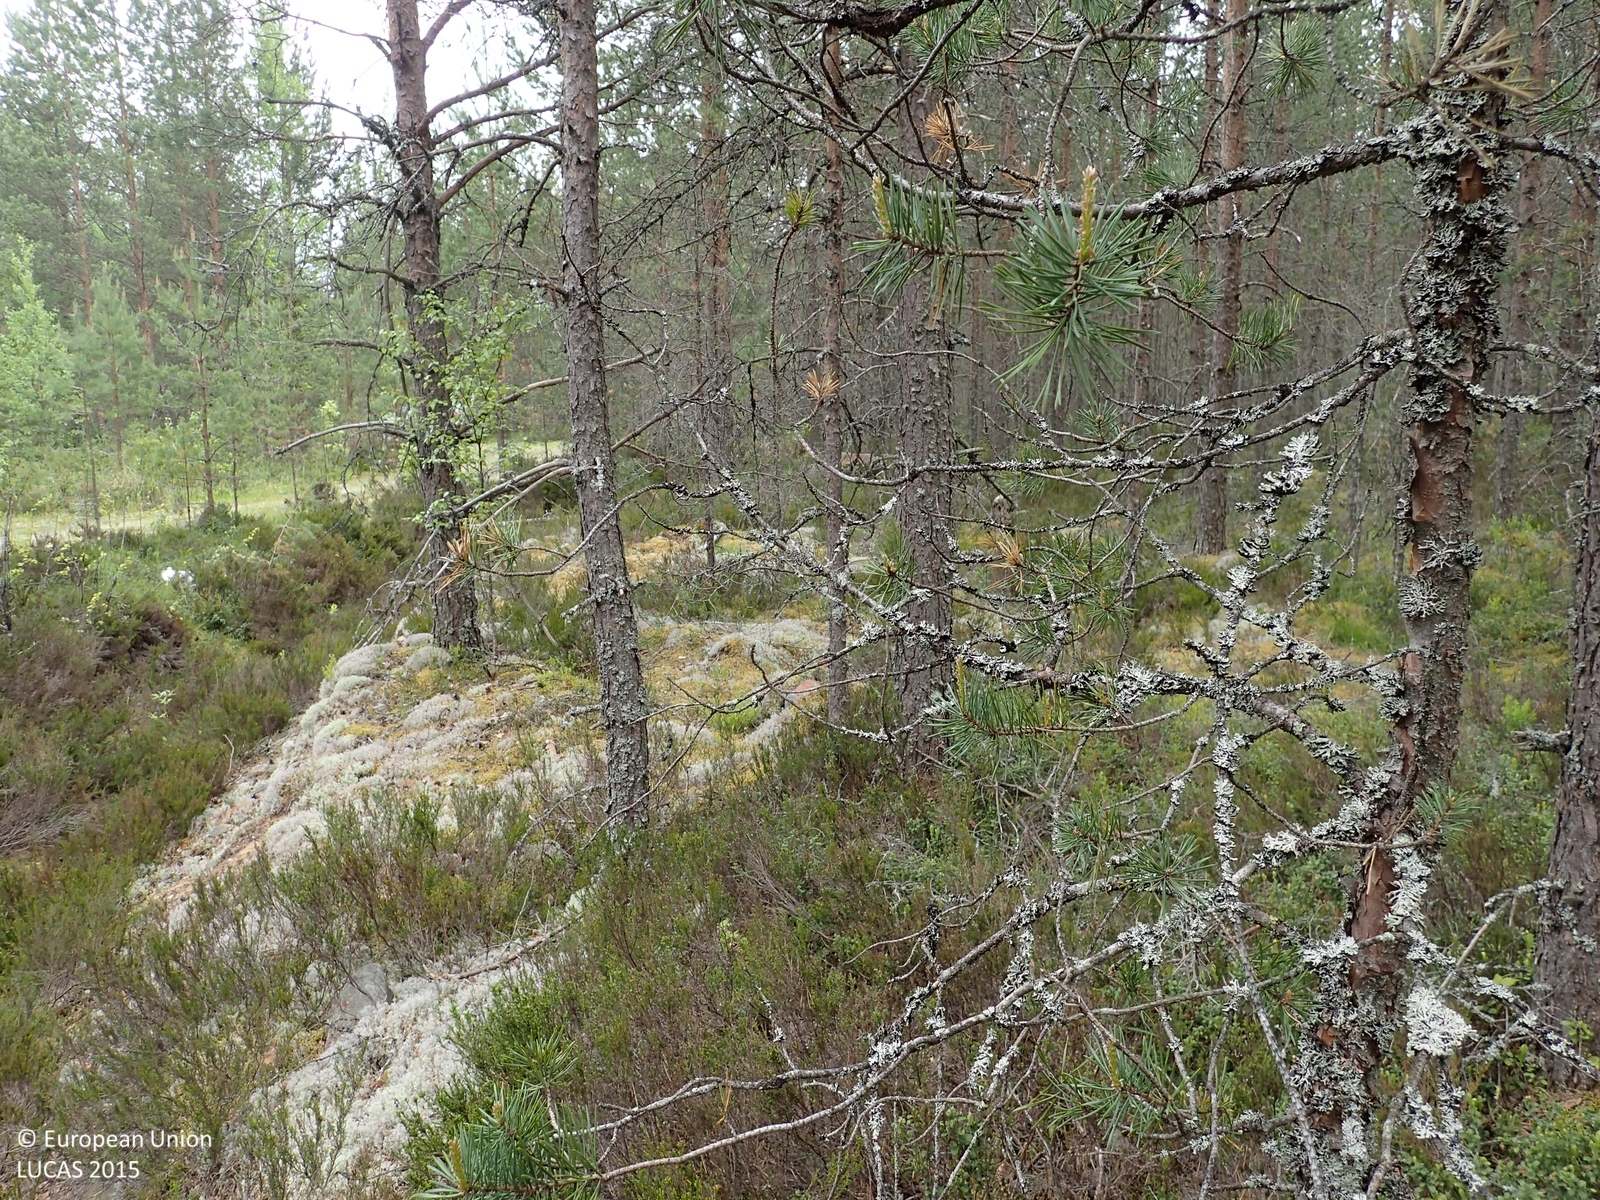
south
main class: Woodland
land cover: Pine dominated coniferous woodland
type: boreal forest
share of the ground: 50 - 75 %
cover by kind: coniferous forest trees 60 %, shrubs 35 %, broadleaved forest trees 5 %
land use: Forestry
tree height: > 5 m
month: June
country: FI
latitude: 62.3473
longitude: 22.4755
